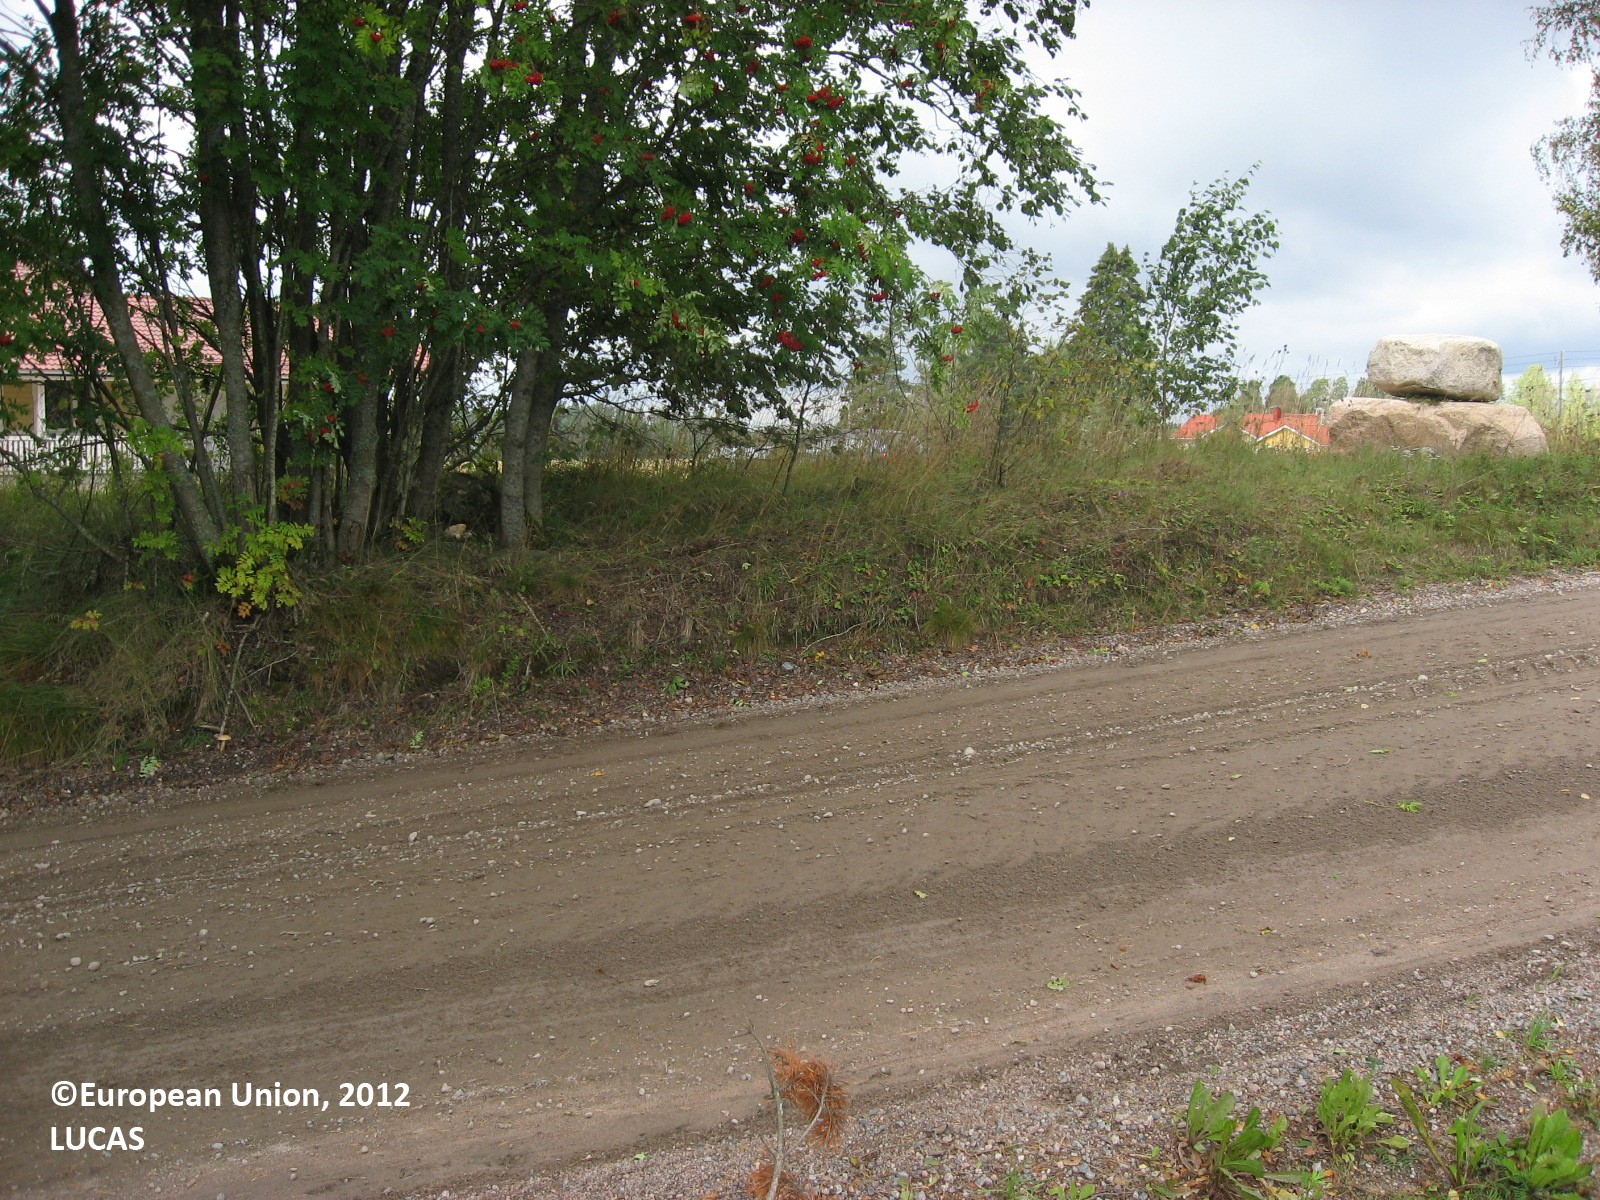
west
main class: Cropland
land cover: Temporary grasslands
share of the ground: > 75 %
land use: Agriculture (excluding fallow land and kitchen gardens)
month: September
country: FI
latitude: 60.8506
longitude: 25.2679
